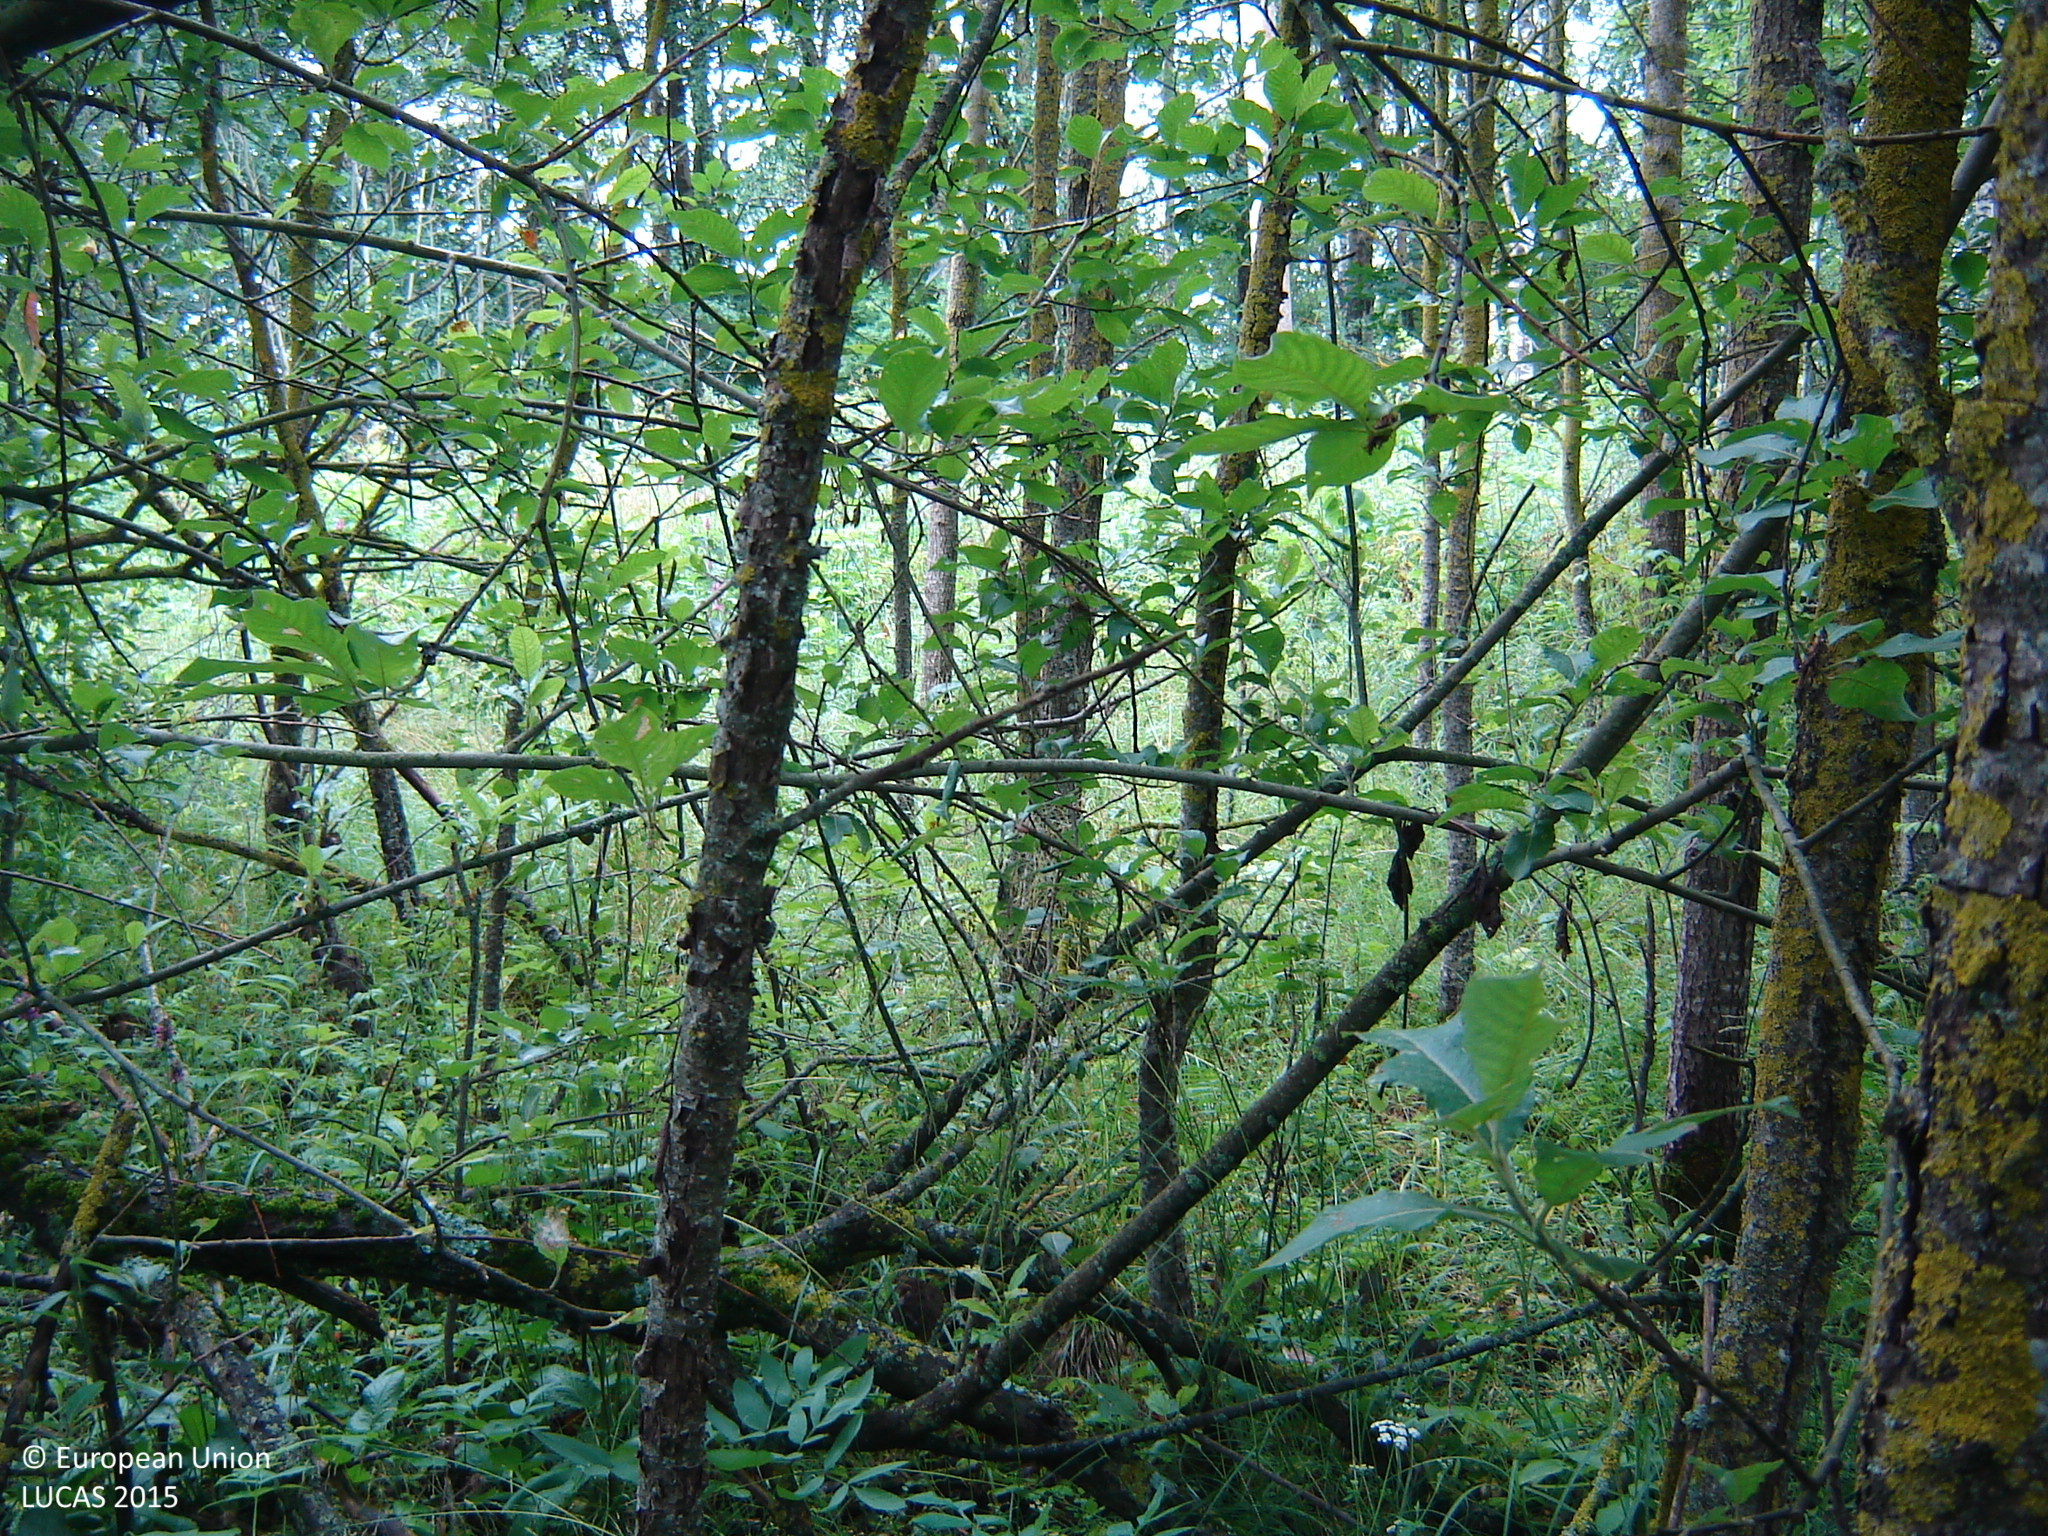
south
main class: Woodland
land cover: Broadleaved woodland
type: non-riverine alder, birch or aspen forest
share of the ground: > 75 %
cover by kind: broadleaved forest trees 90 %, herbaceous plants 10 %
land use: Forestry
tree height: > 5 m
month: July
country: LT
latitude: 55.3330
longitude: 25.1712
